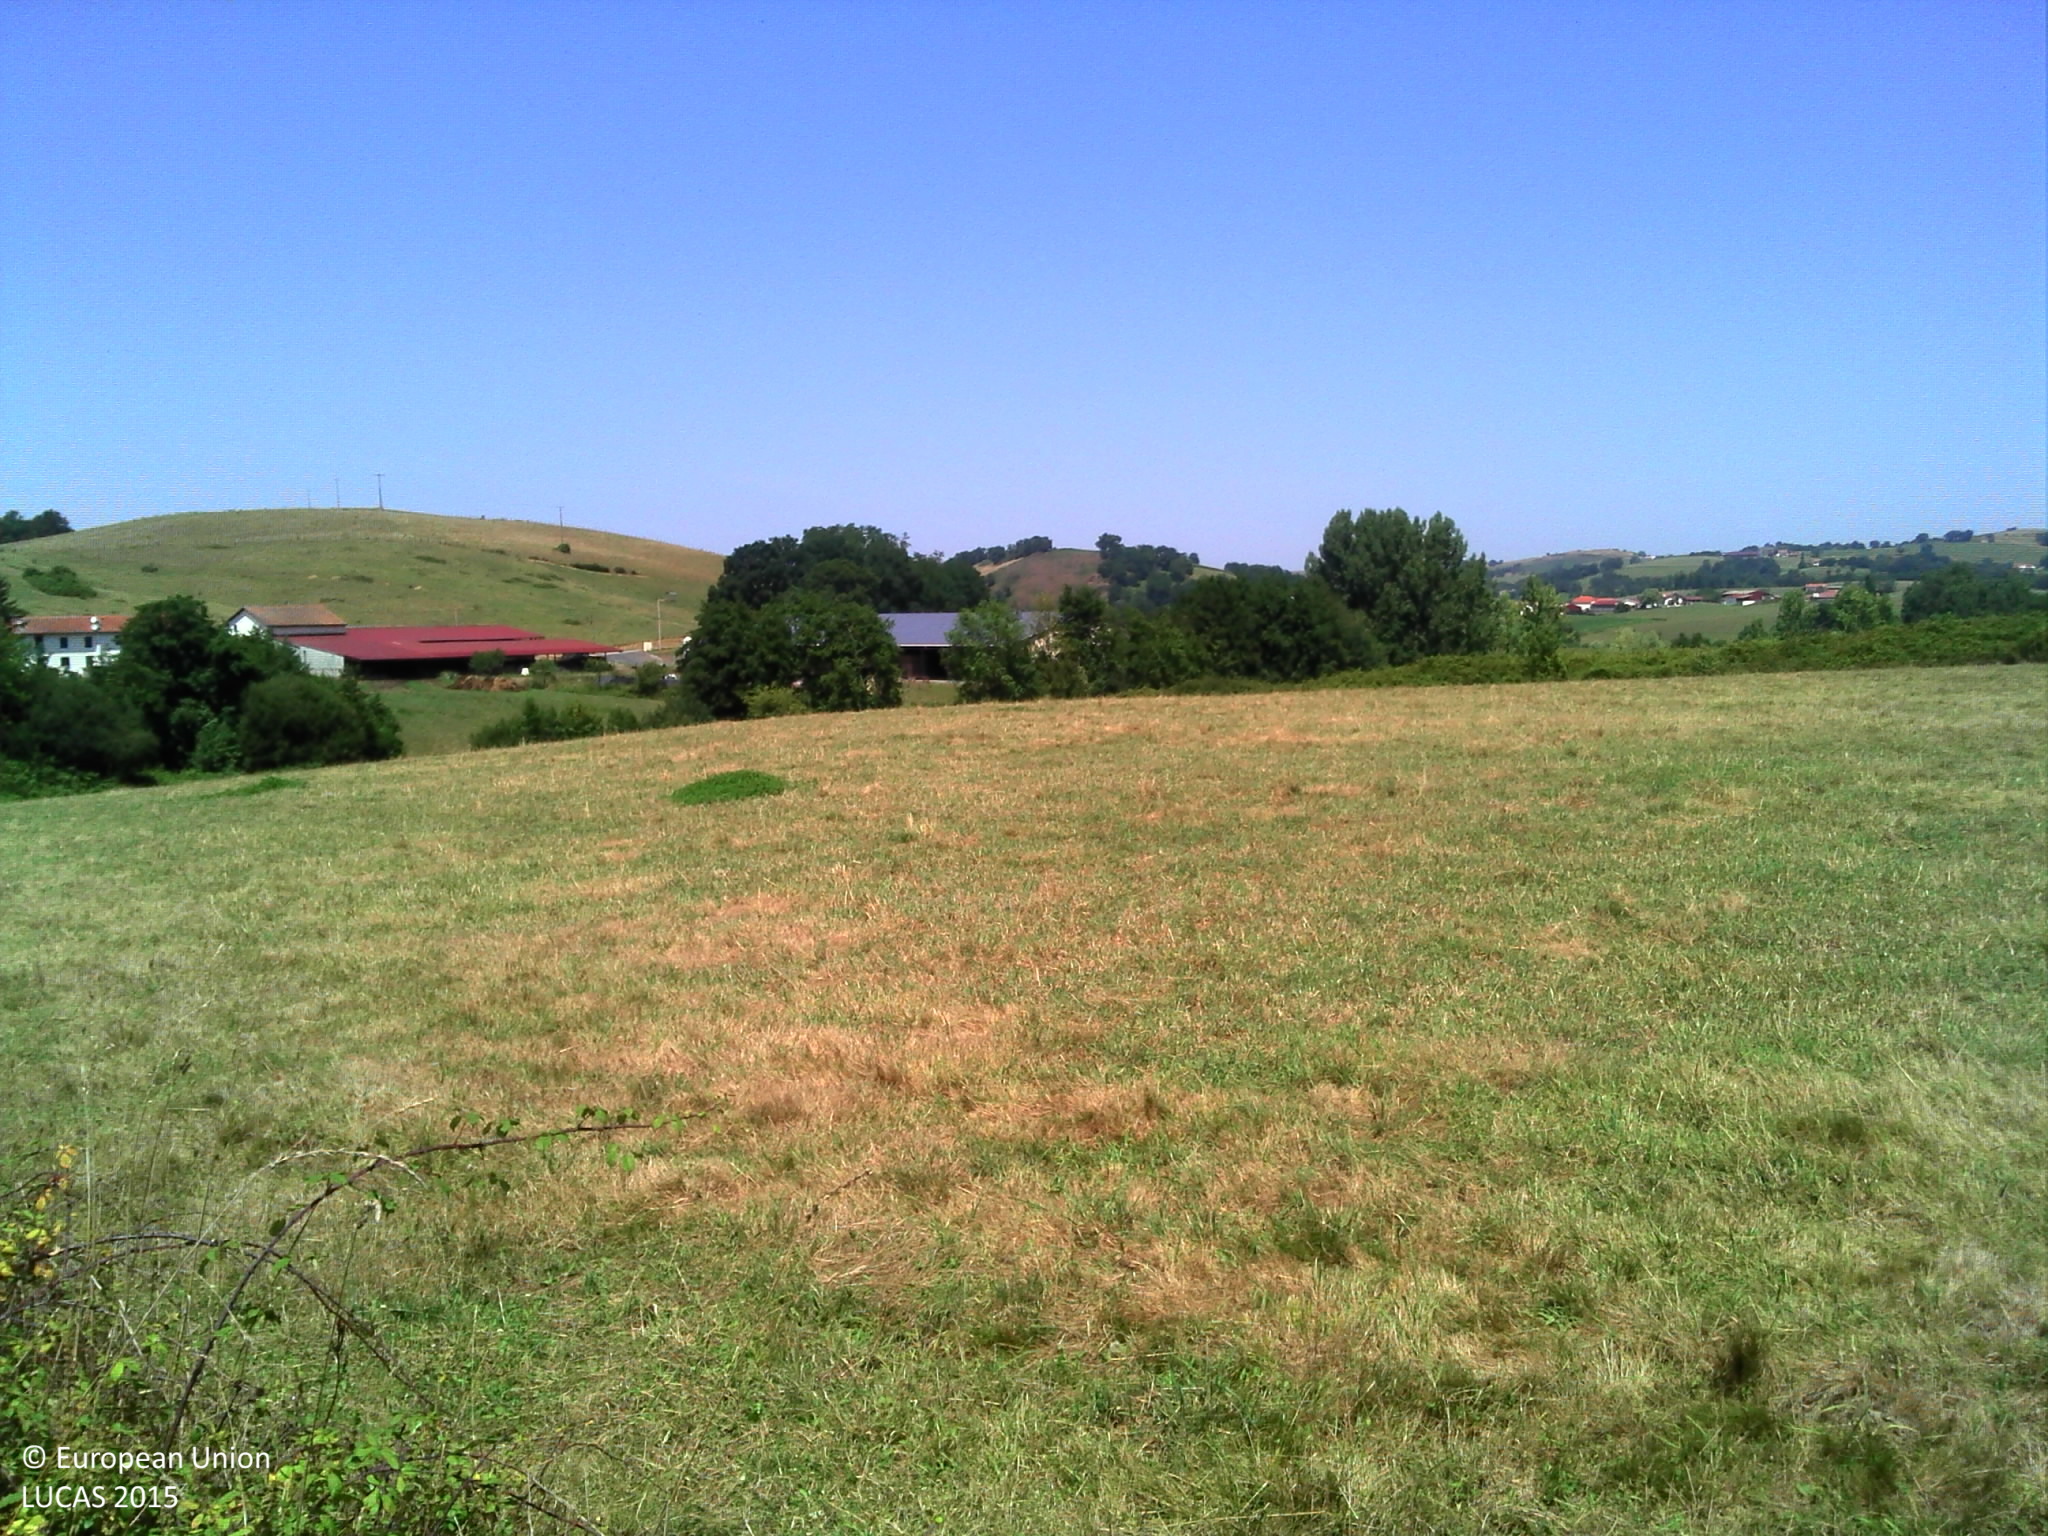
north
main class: Cropland
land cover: Maize
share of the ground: > 75 %
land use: Agriculture (excluding fallow land and kitchen gardens)
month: August
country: FR
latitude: 43.3113
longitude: -1.1469
